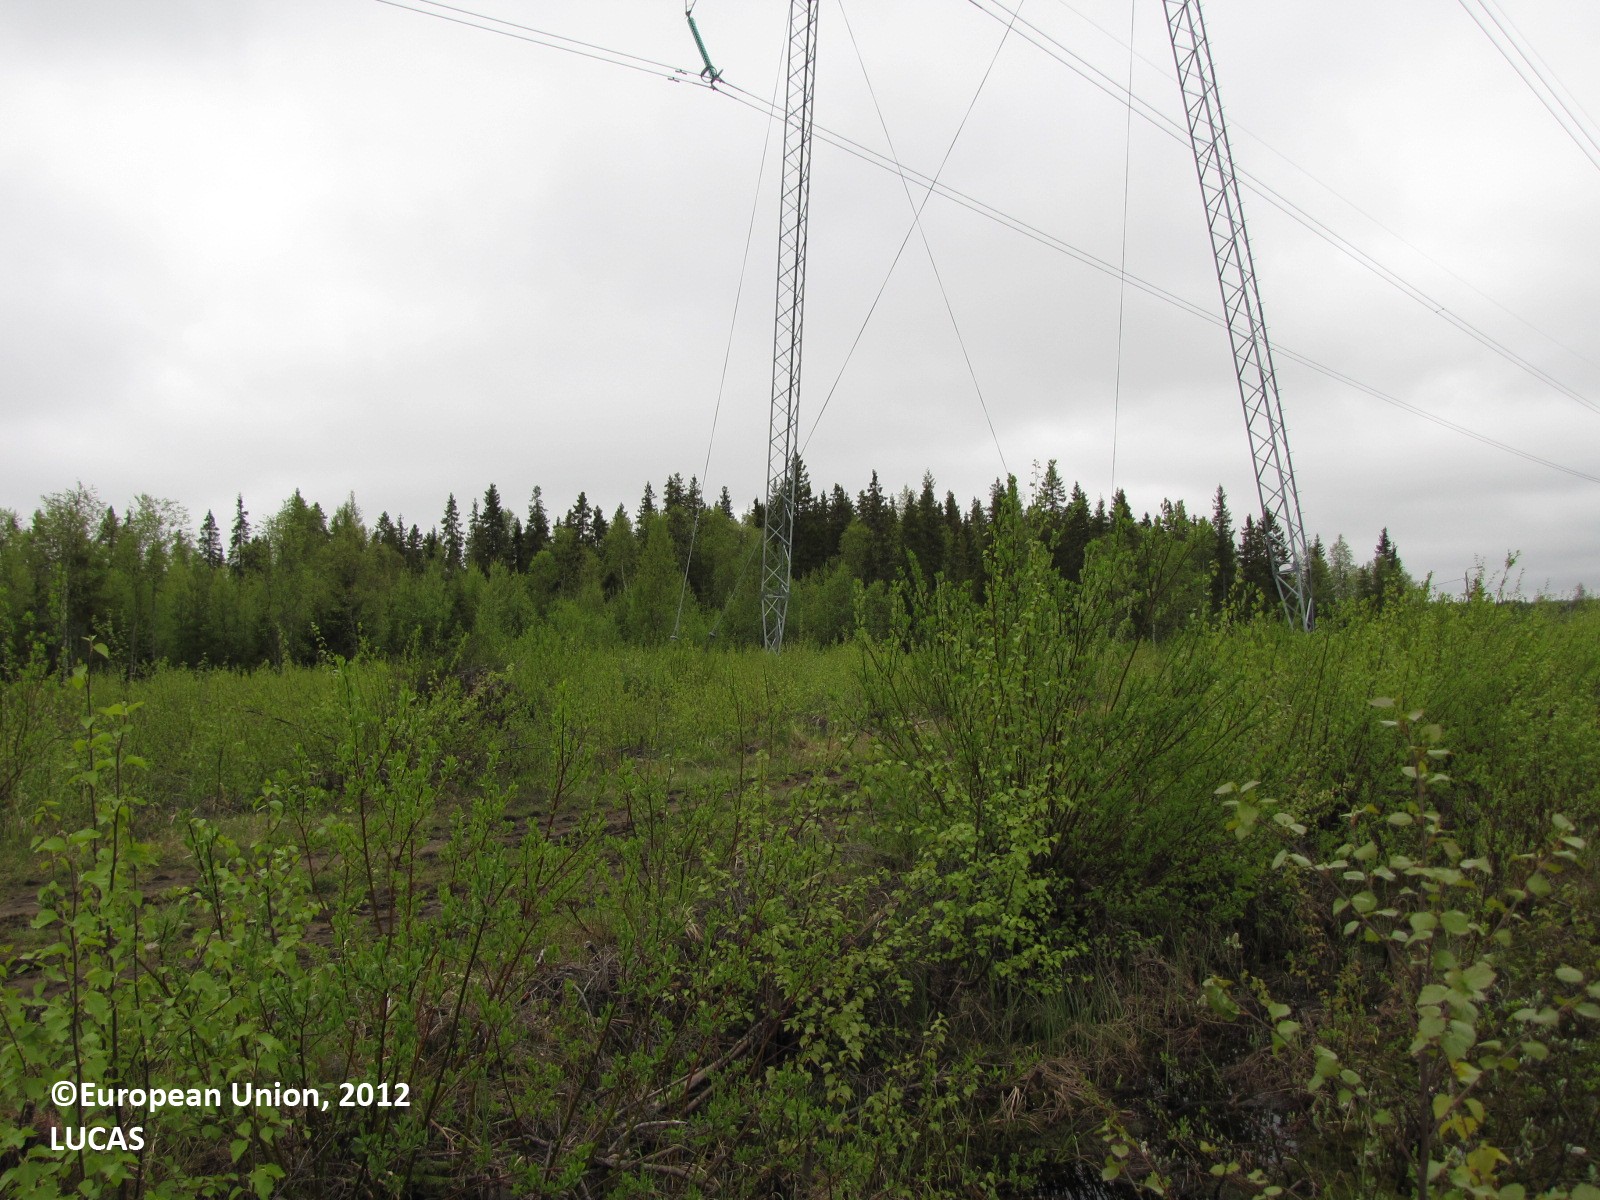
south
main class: Shrubland
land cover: Shrubland with sparse tree cover
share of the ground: > 75 %
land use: Energy production
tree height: < 5 m
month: June
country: FI
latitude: 65.9610
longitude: 24.0579
